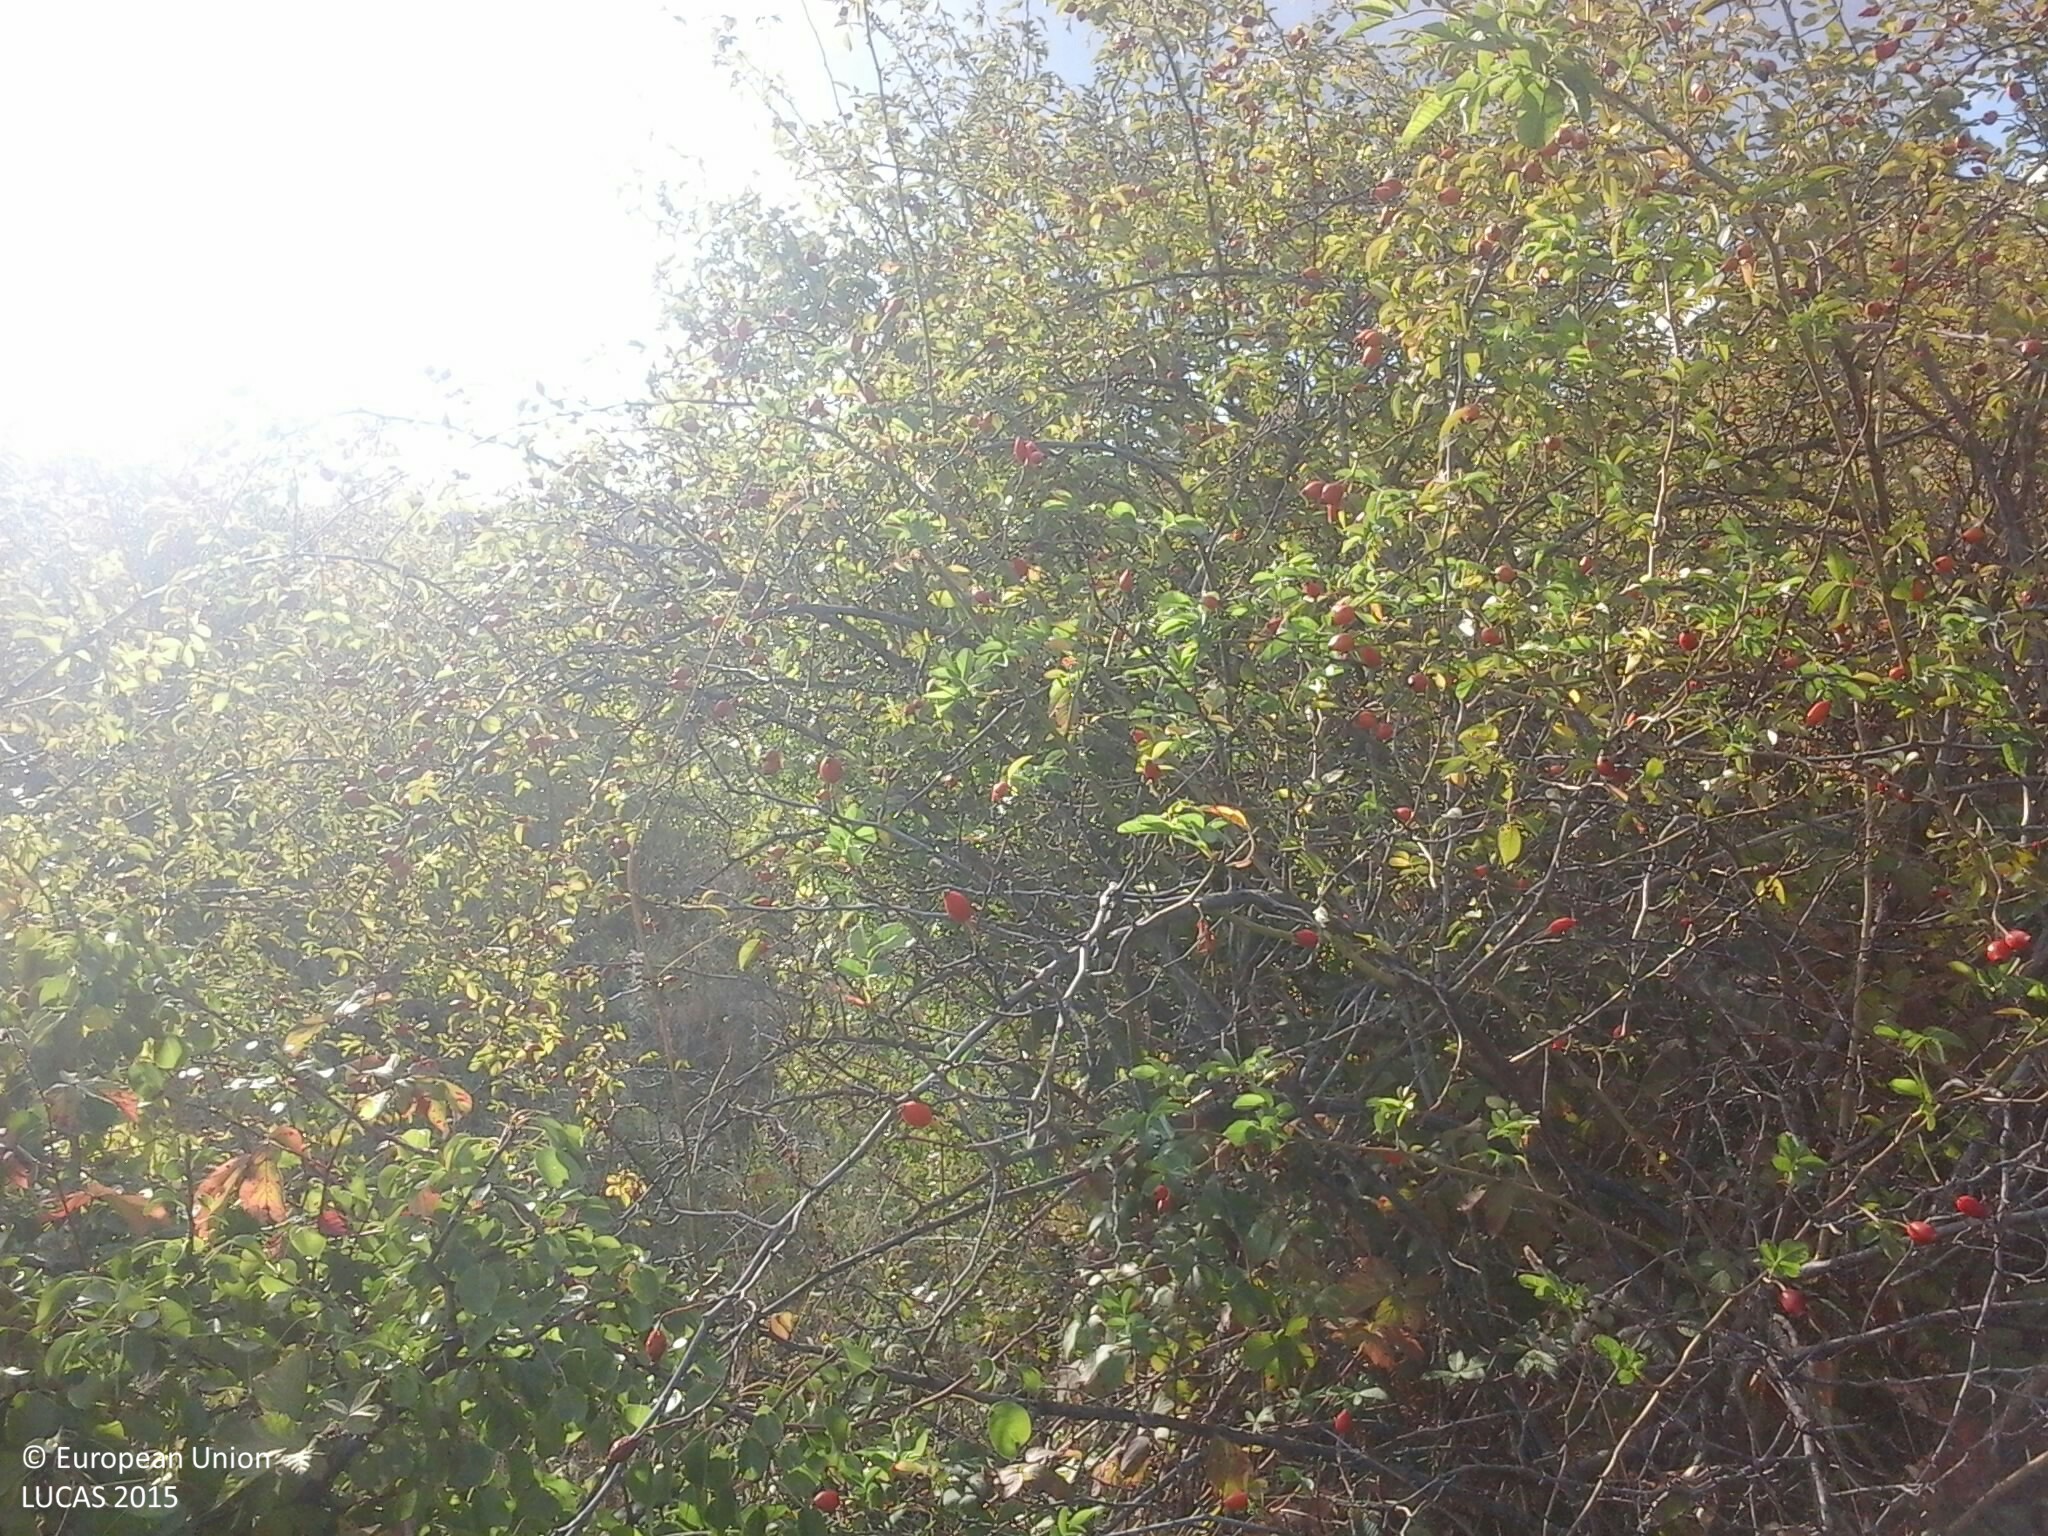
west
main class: Shrubland
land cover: Shrubland without tree cover
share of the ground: > 75 %
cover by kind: shrubs 75 %, herbaceous plants 25 %
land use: Semi-natural and natural areas not in use
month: September
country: HU
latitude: 47.8217
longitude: 20.0048
